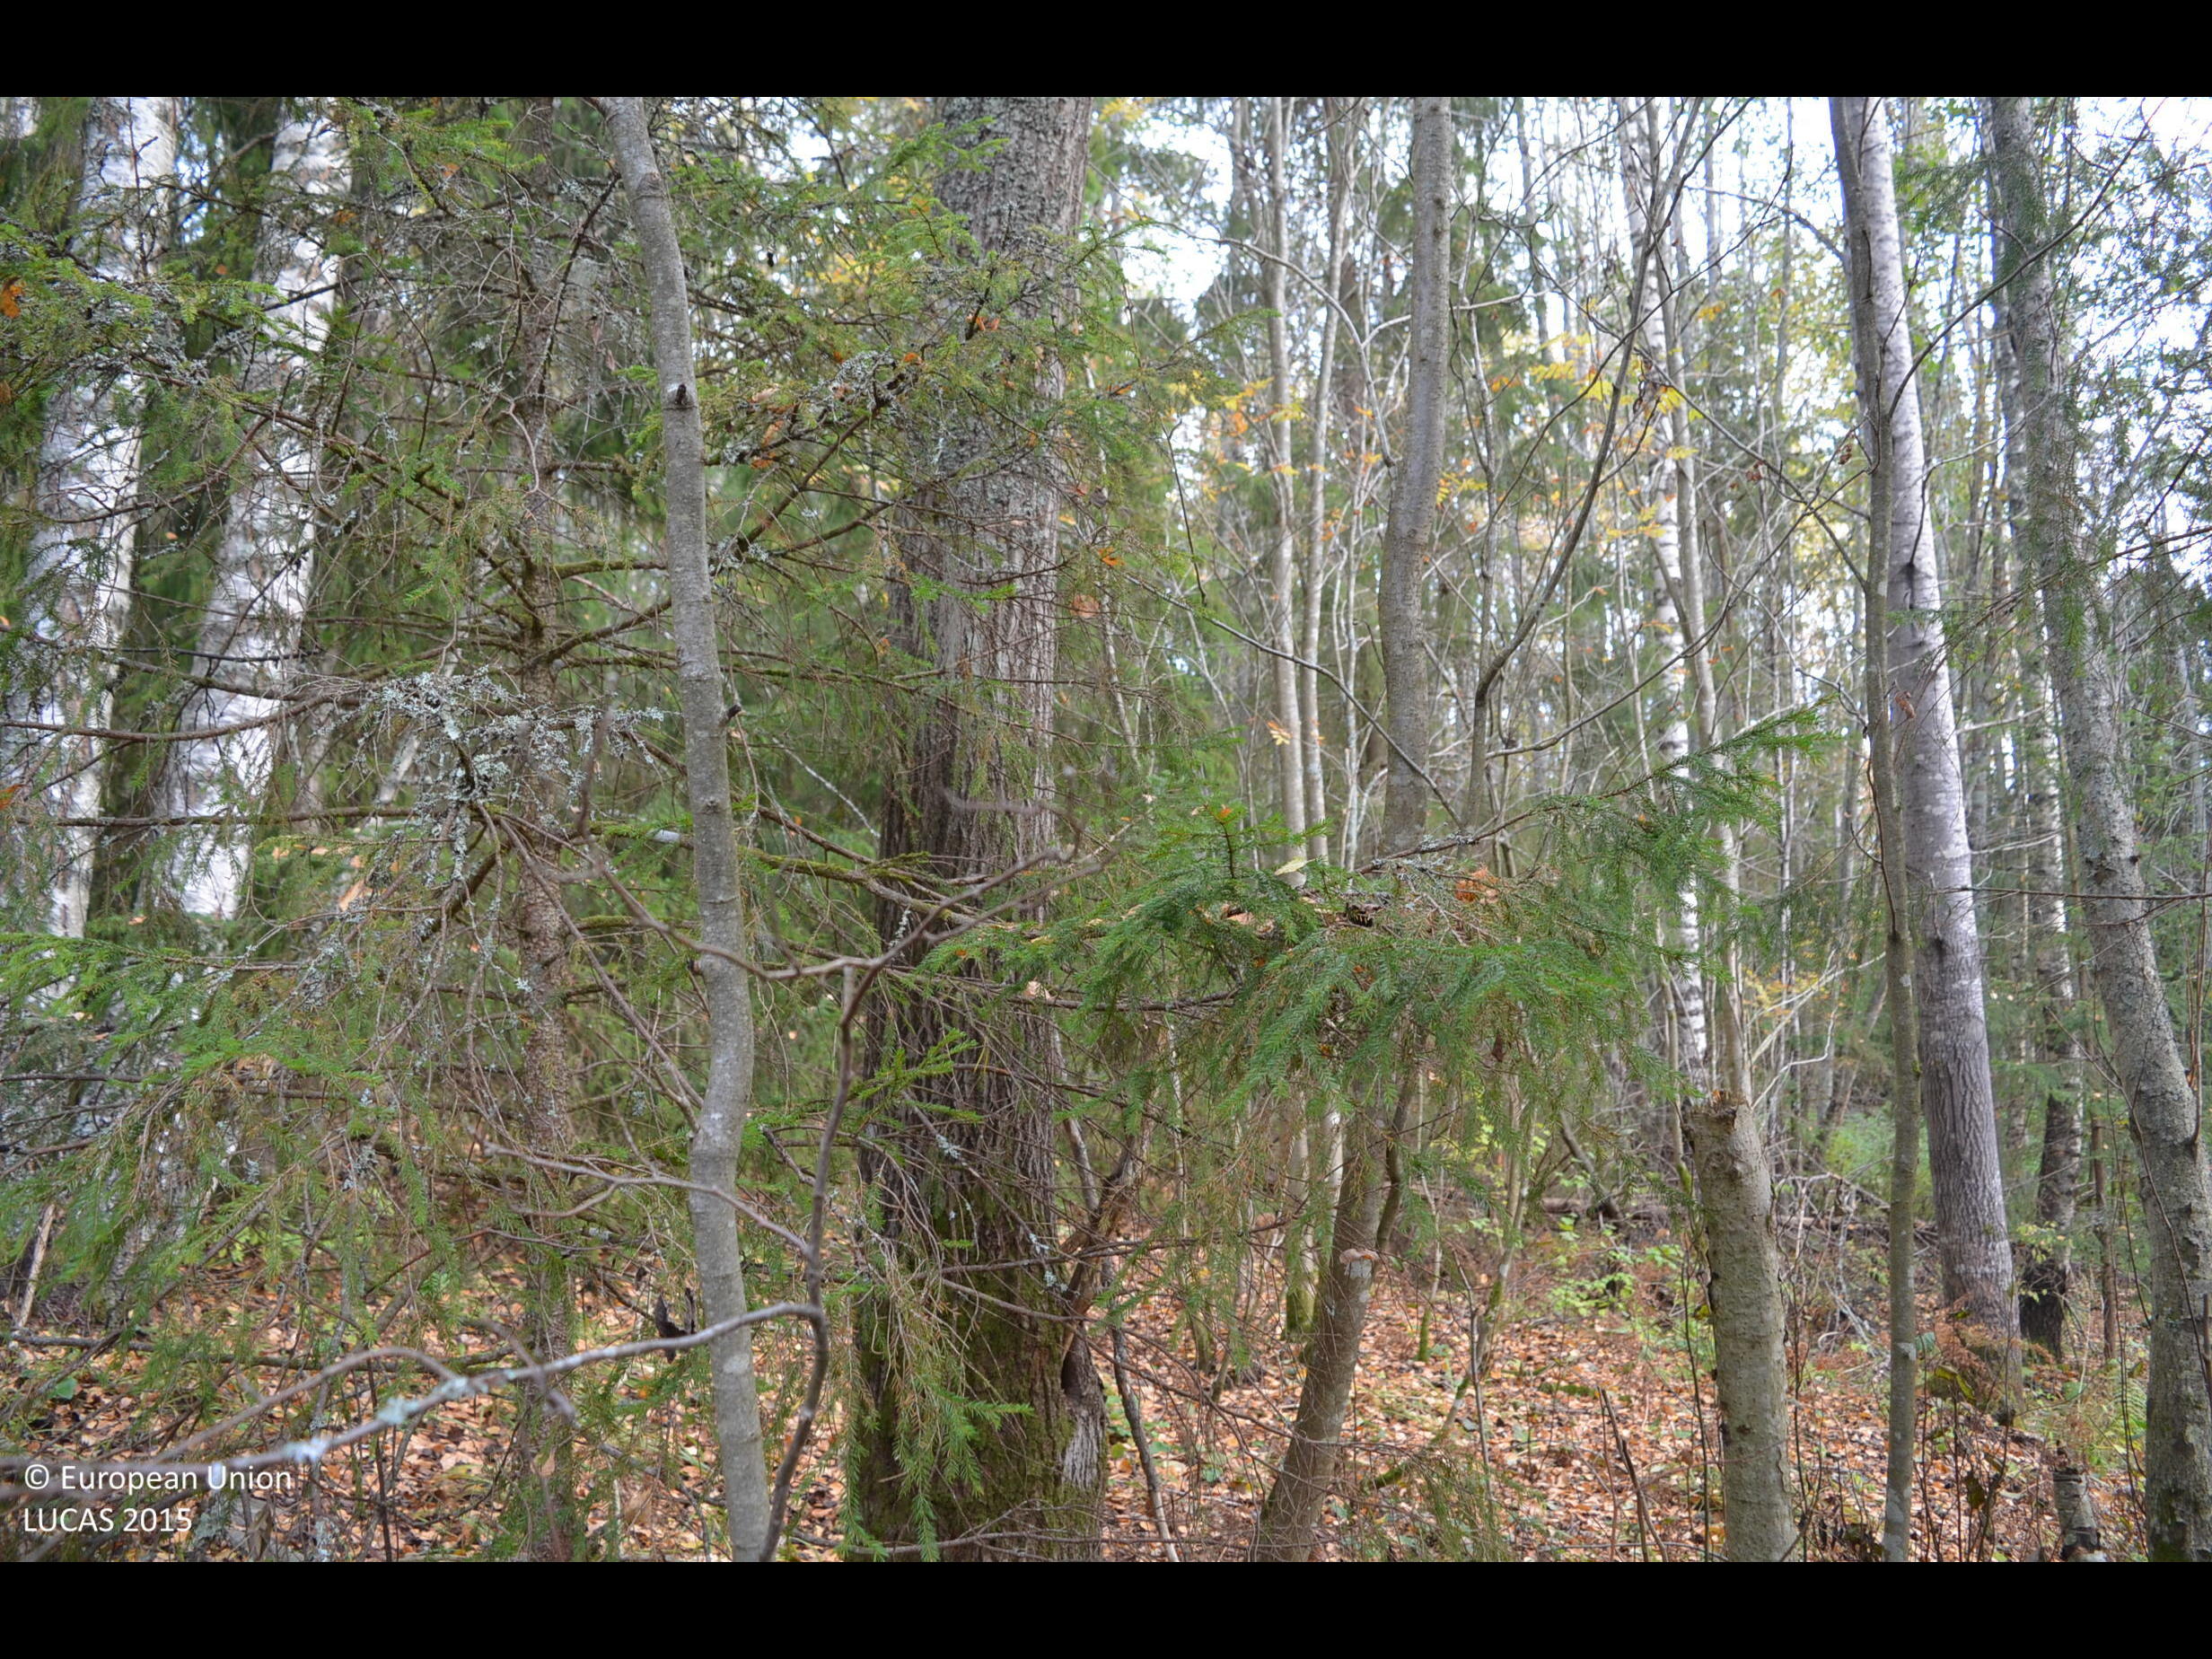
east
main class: Woodland
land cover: Spruce dominated mixed woodland
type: boreal forest
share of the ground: 50 - 75 %
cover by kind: broadleaved forest trees 35 %, coniferous forest trees 25 %, shrubs 10 %, herbaceous plants 10 %, lichens and mosses 10 %
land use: Forestry
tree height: > 5 m
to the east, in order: Spruce dominated mixed woodland; Other mixed woodland; Grassland with sparse tree/shrub cover
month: October
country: FI
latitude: 61.4786
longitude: 23.1973
